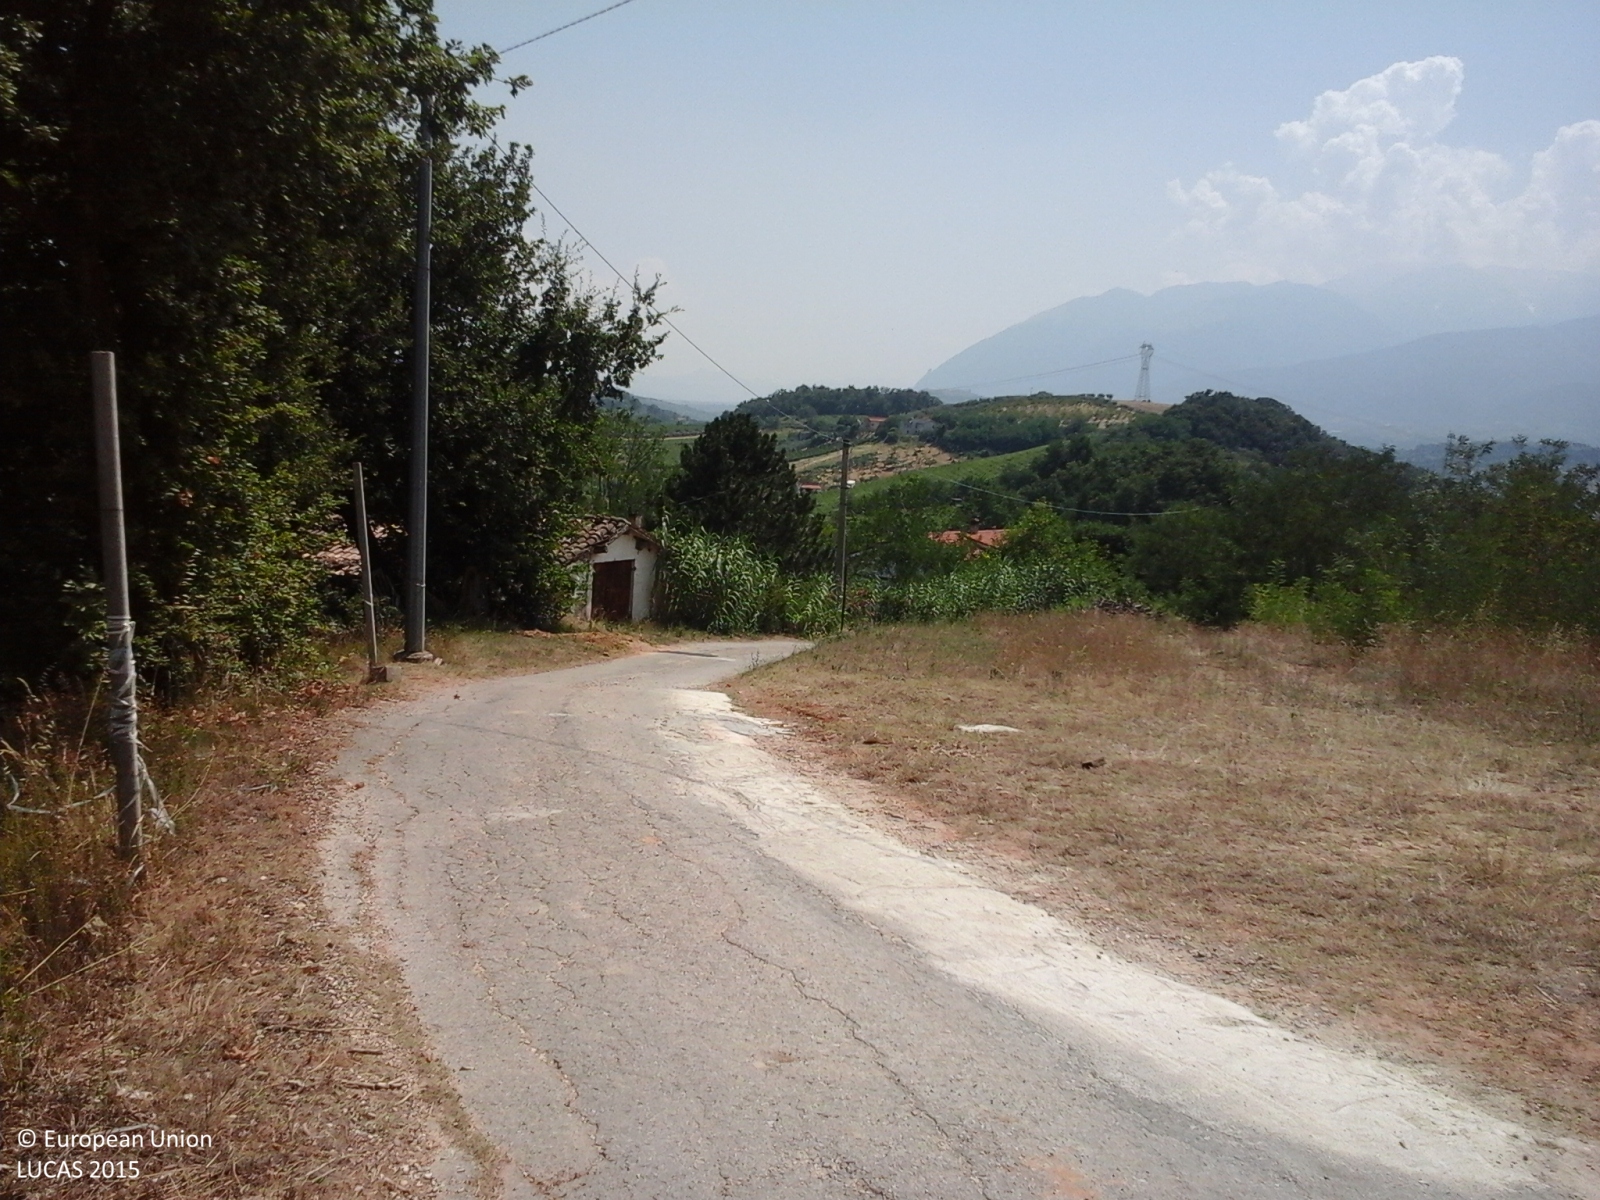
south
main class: Cropland
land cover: Tomatoes
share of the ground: > 75 %
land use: Agriculture (excluding fallow land and kitchen gardens)
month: July
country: IT
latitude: 42.2577
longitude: 14.2417
